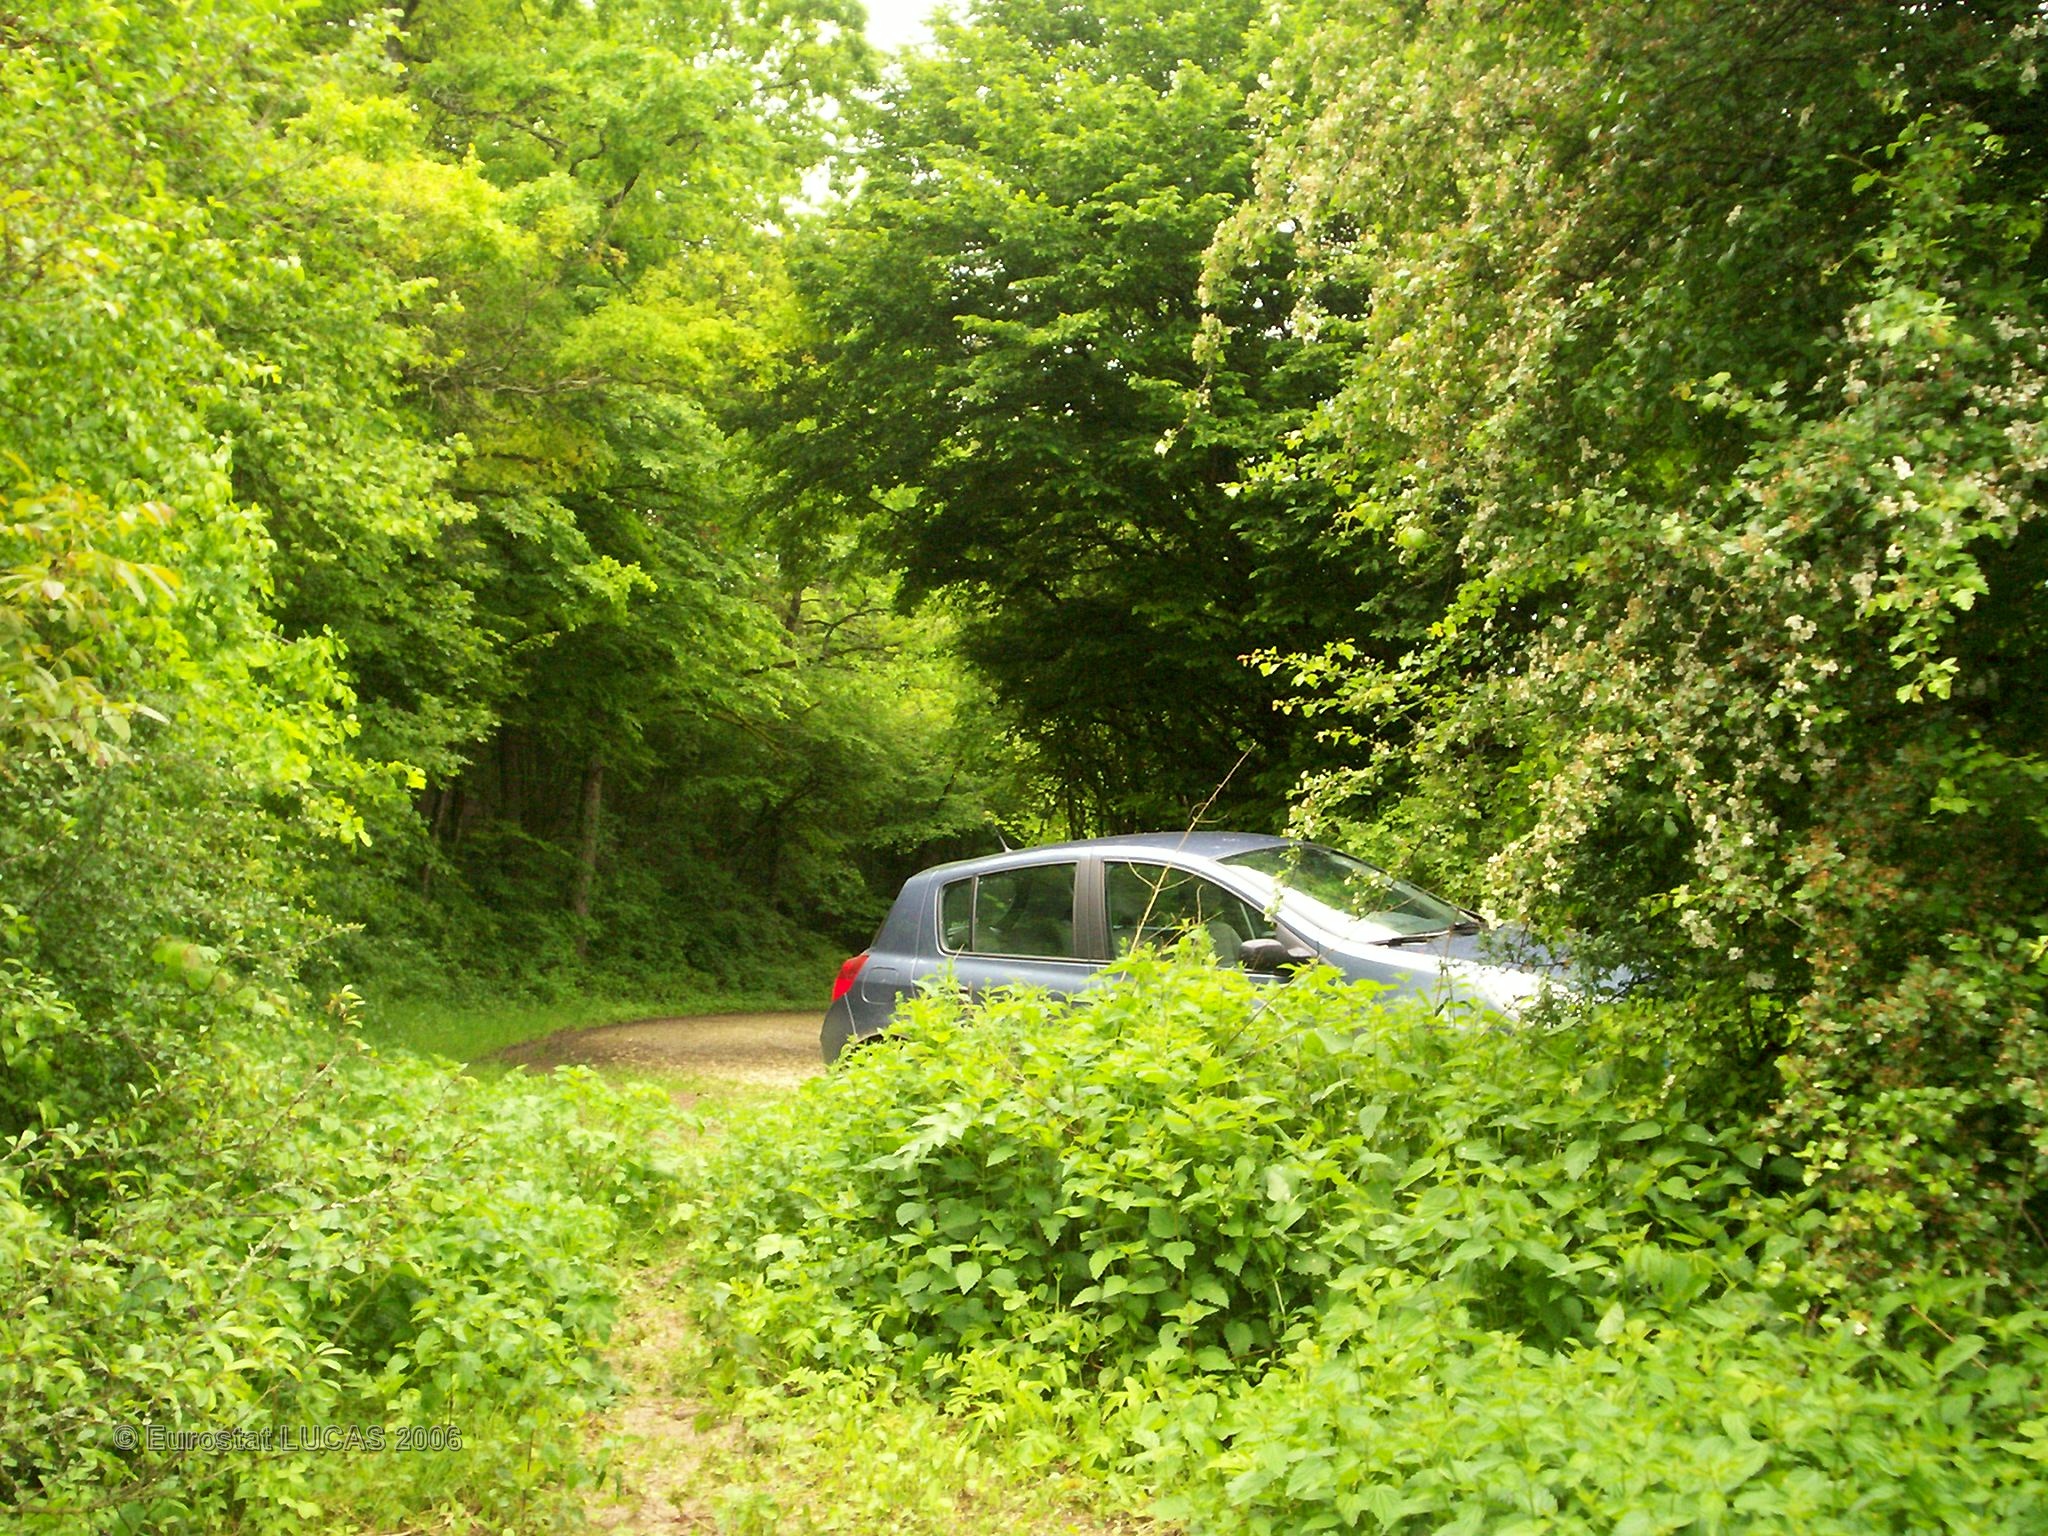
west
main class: Grassland
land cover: Grassland without tree/shrub cover
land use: Agriculture (excluding fallow land and kitchen gardens)
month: May
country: FR
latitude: 47.6553
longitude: 3.8591
